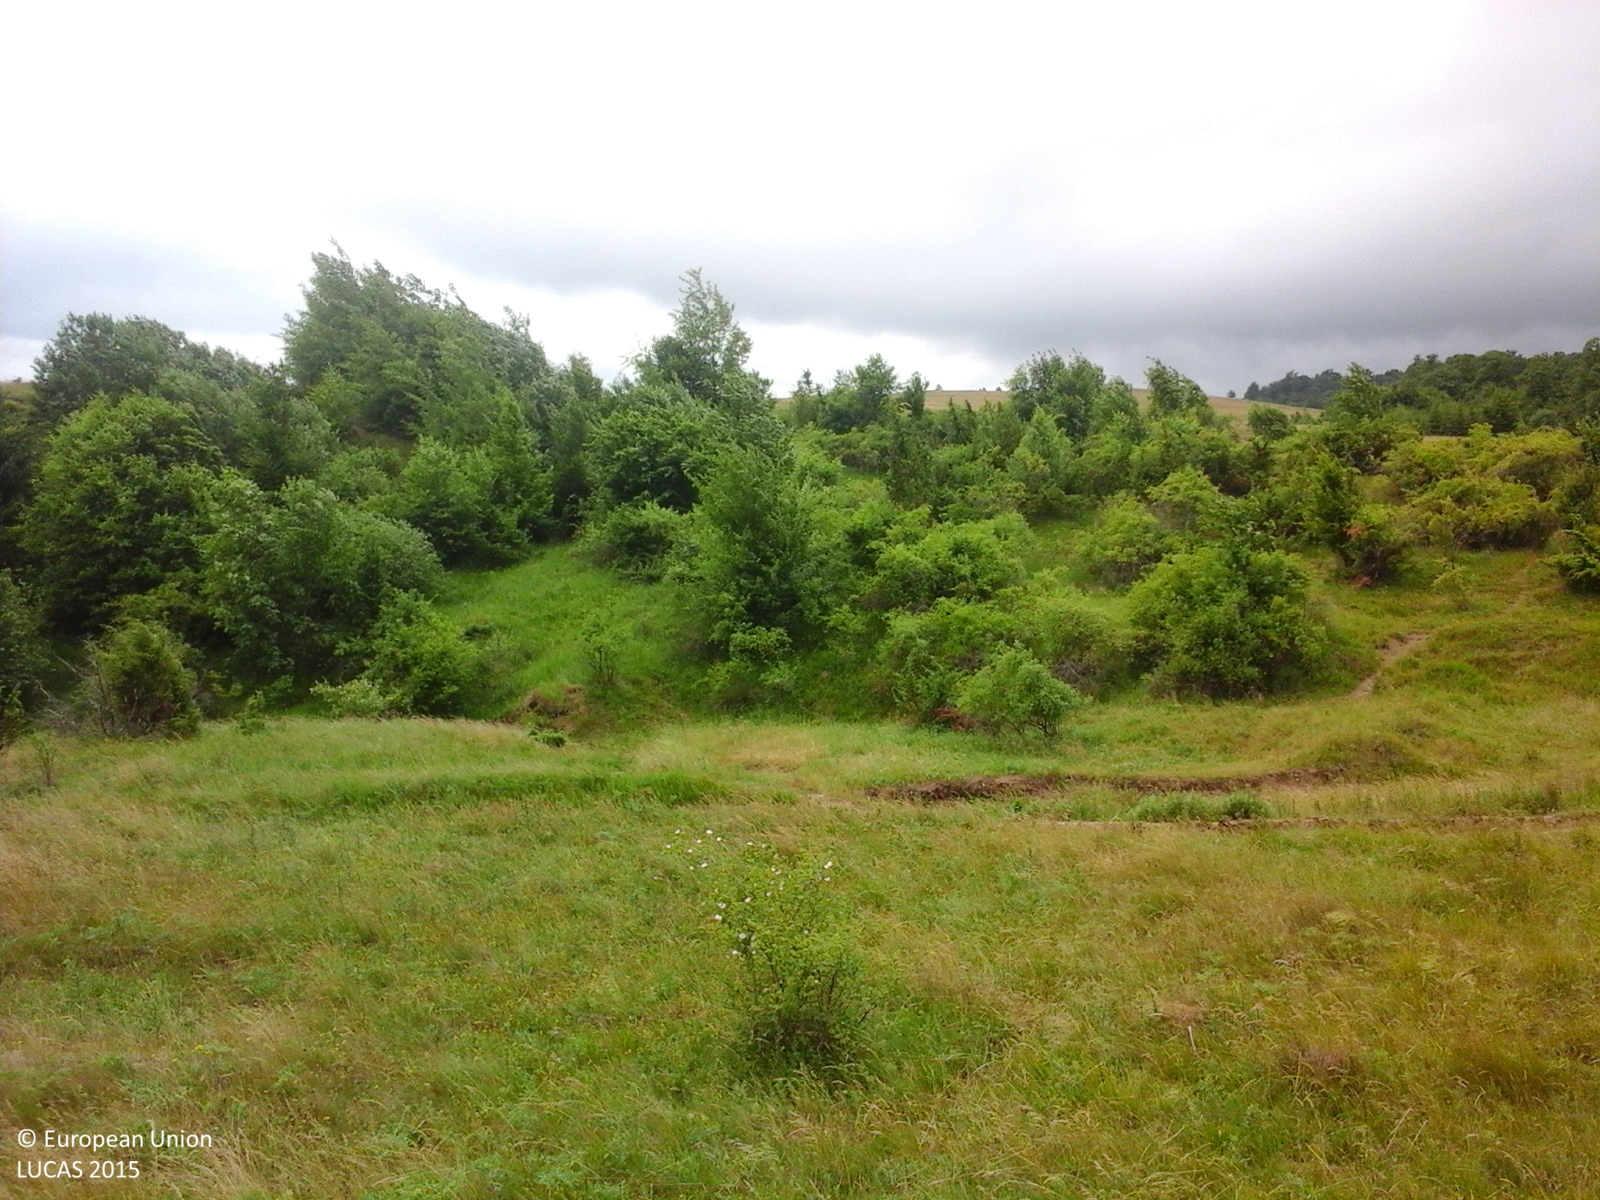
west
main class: Grassland
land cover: Grassland with sparse tree/shrub cover
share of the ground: > 75 %
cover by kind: herbaceous plants 85 %, shrubs 10 %, broadleaved forest trees 5 %
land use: Agriculture (excluding fallow land and kitchen gardens)
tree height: < 5 m
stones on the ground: < 10 %
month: June
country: RO
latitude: 47.1871
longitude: 26.2736
